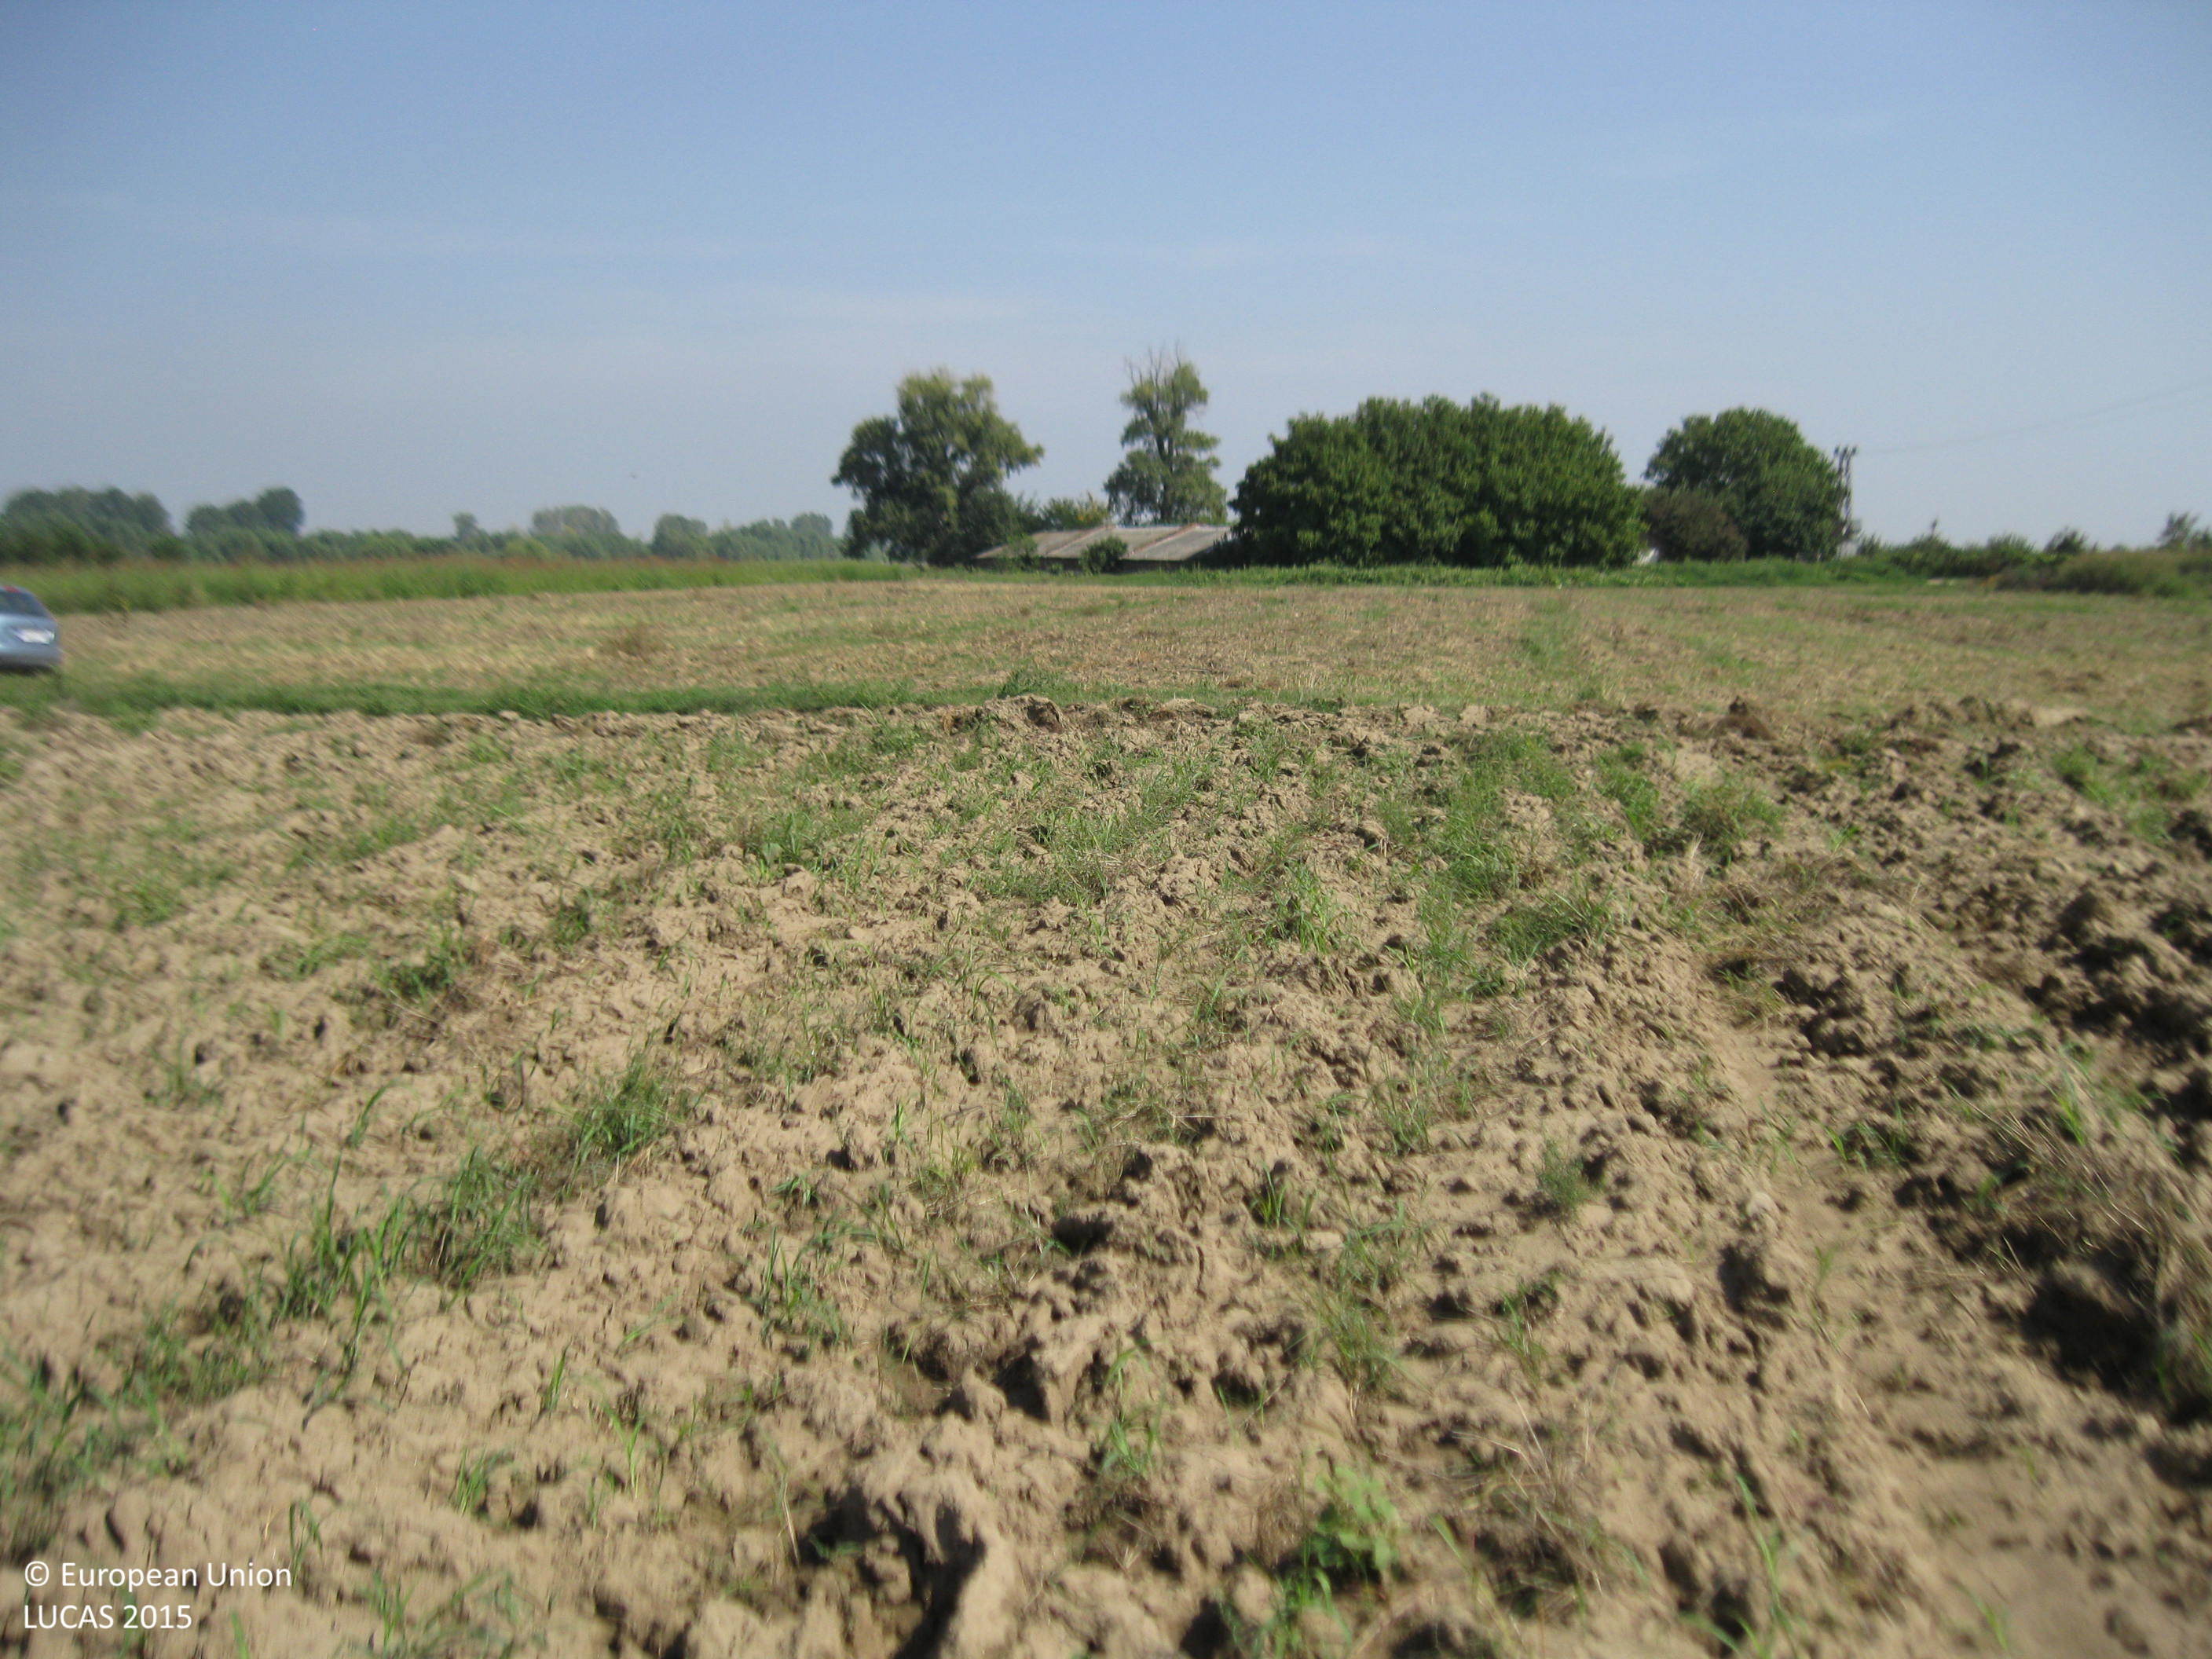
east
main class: Cropland
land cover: Common wheat
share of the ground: < 10 %
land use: Agriculture (excluding fallow land and kitchen gardens)
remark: Harvested field
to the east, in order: Common wheat; Grass margins; Tracks; Grass margins; Common wheat; Grass margins; Tracks; Broadleaved woodland; Artificial constructions in urban areas; Grass margins; Tracks; Grass margins; Lucerne
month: September
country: BG
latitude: 42.1457
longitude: 24.5565
